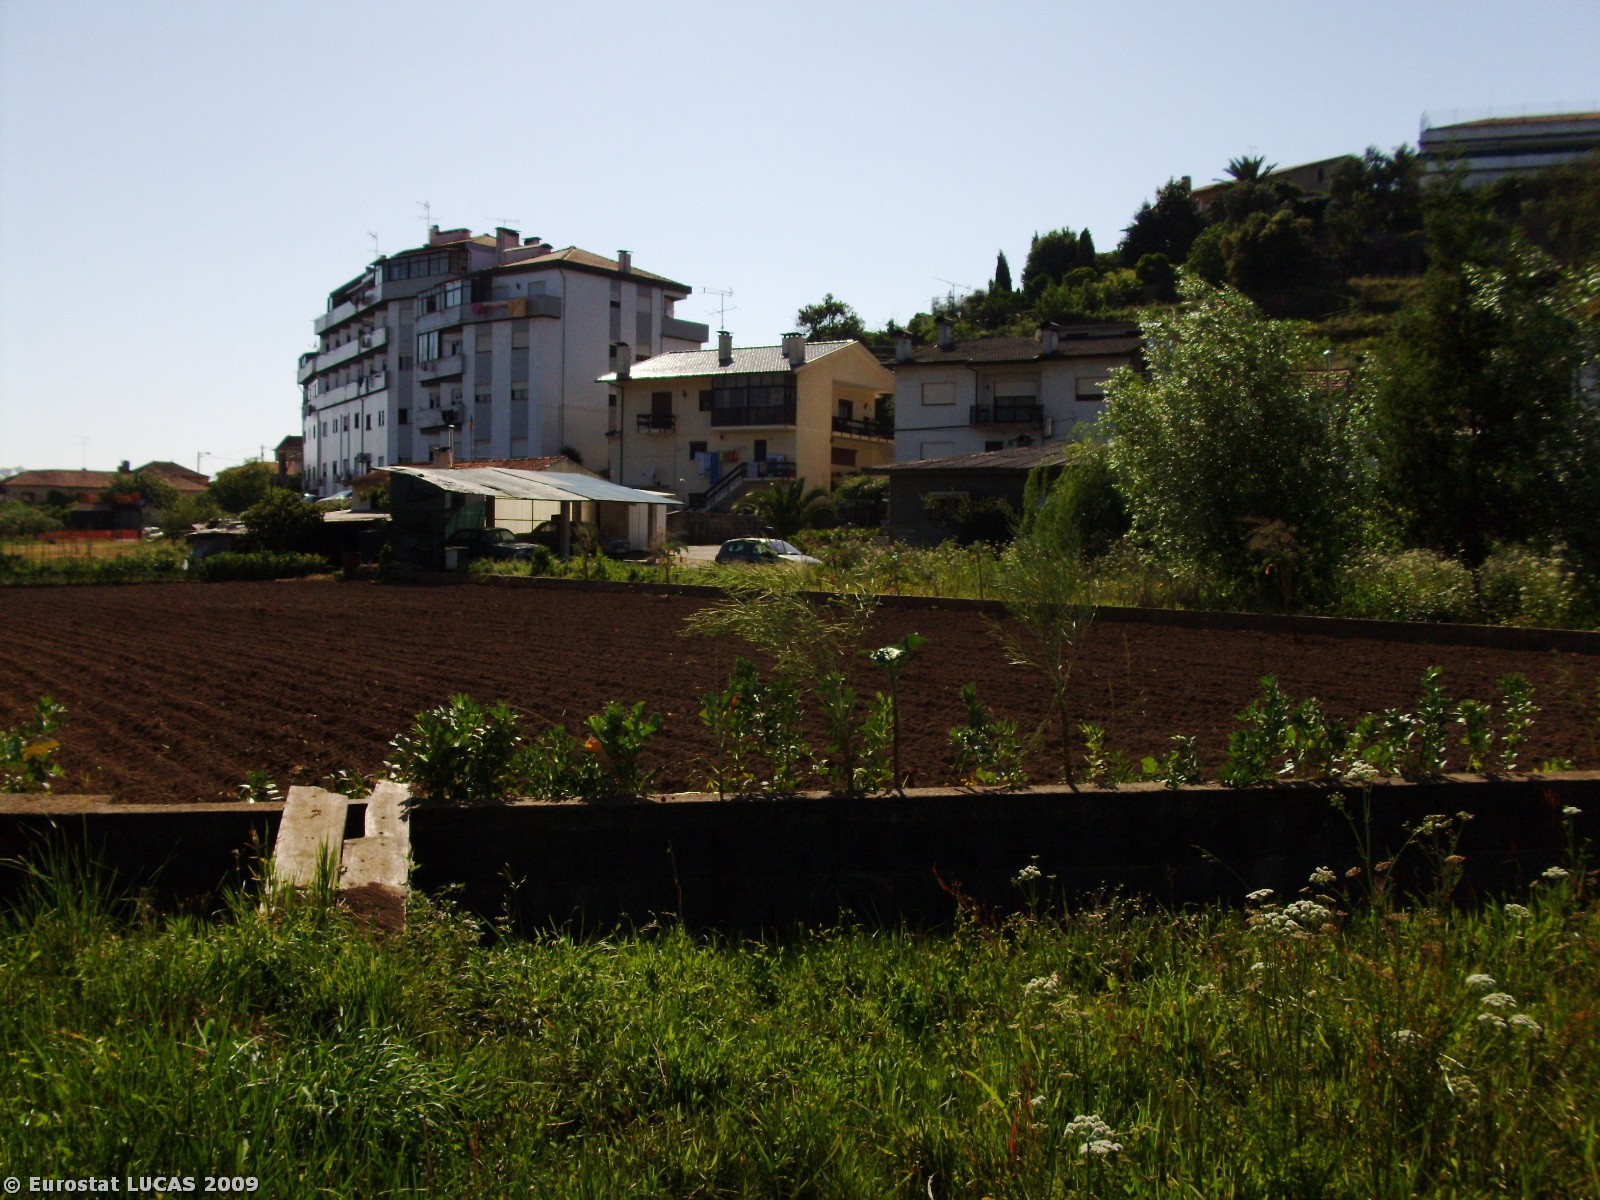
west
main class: Grassland
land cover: Spontaneously vegetated surfaces
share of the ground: > 75 %
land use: Fallow land
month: May
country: PT
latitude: 40.5746
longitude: -8.4355
